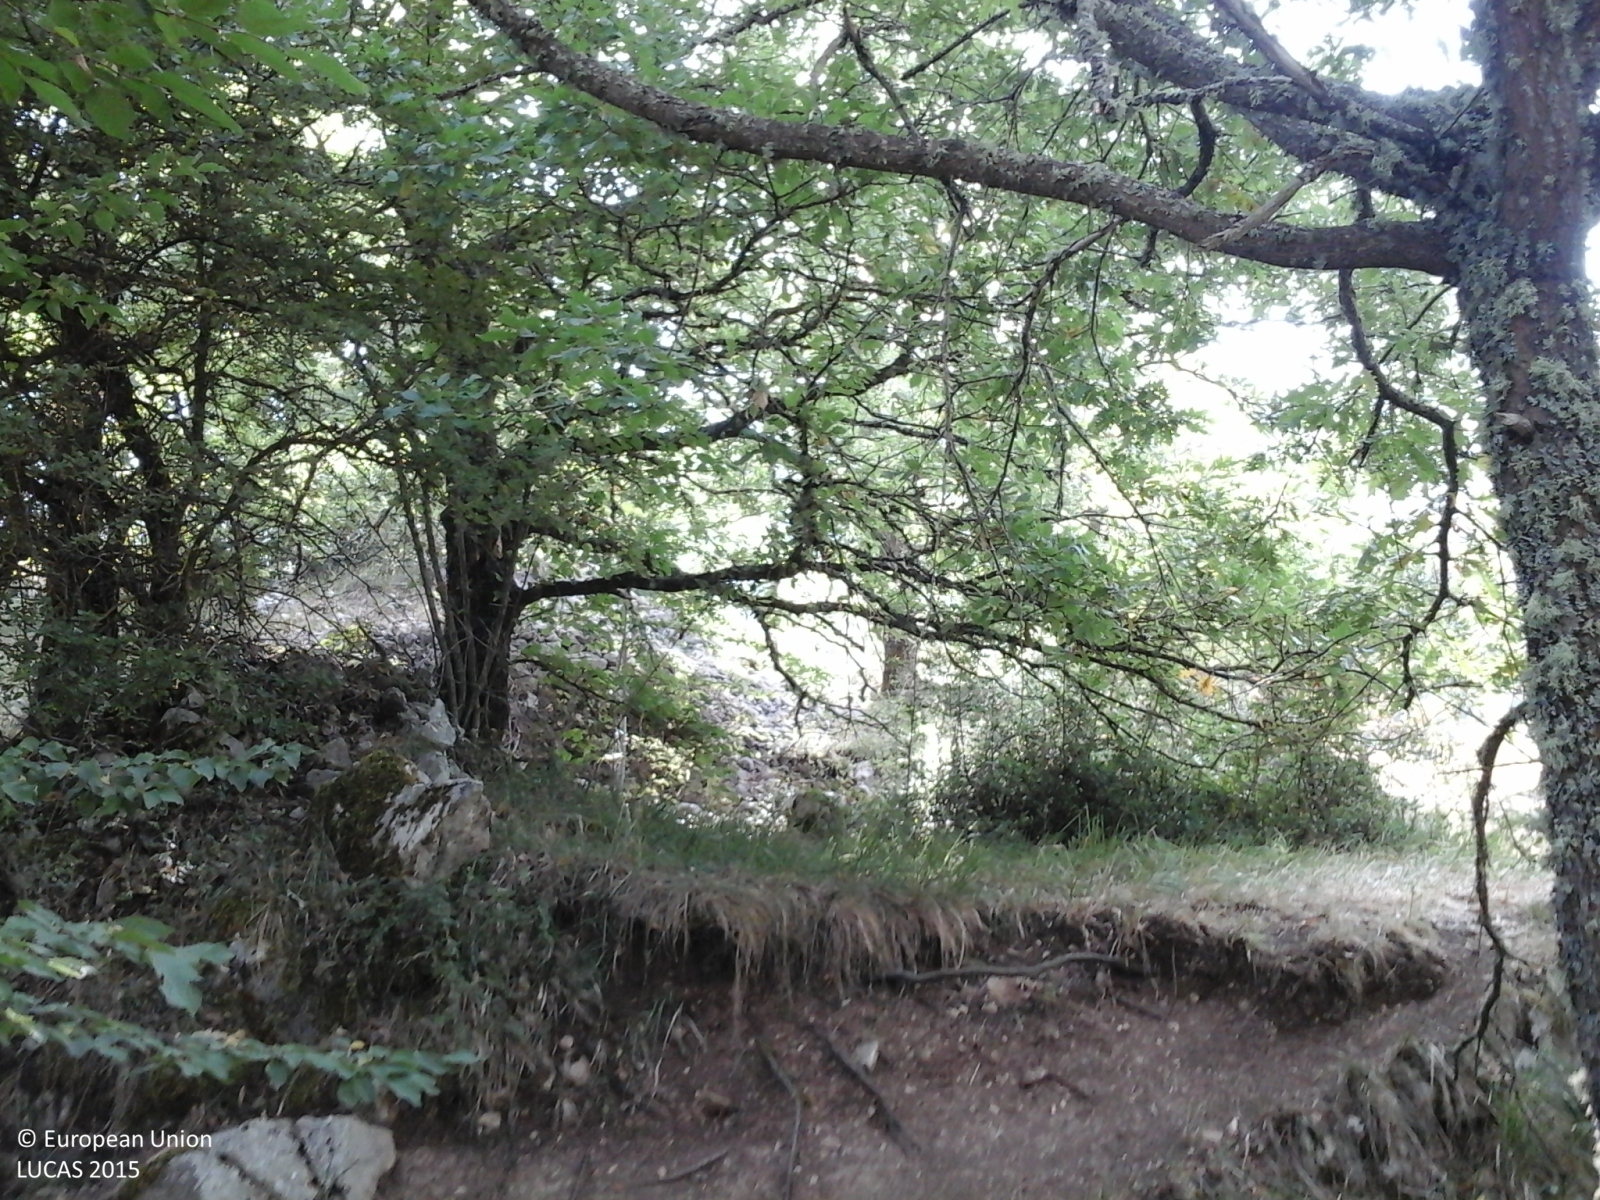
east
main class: Woodland
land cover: Broadleaved woodland
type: thermophilous deciduous forest
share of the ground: > 75 %
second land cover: Grassland without tree/shrub cover
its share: > 75 %
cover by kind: broadleaved forest trees 80 %, herbaceous plants 15 %, shrubs 5 %
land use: Forestry
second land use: Agriculture (excluding fallow land and kitchen gardens)
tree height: > 5 m
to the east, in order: Broadleaved woodland; Grassland without tree/shrub cover; Broadleaved woodland; Grassland with sparse tree/shrub cover; Rocks and stones; Grassland with sparse tree/shrub cover; Broadleaved woodland
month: September
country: IT
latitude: 41.6604
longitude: 14.2483
